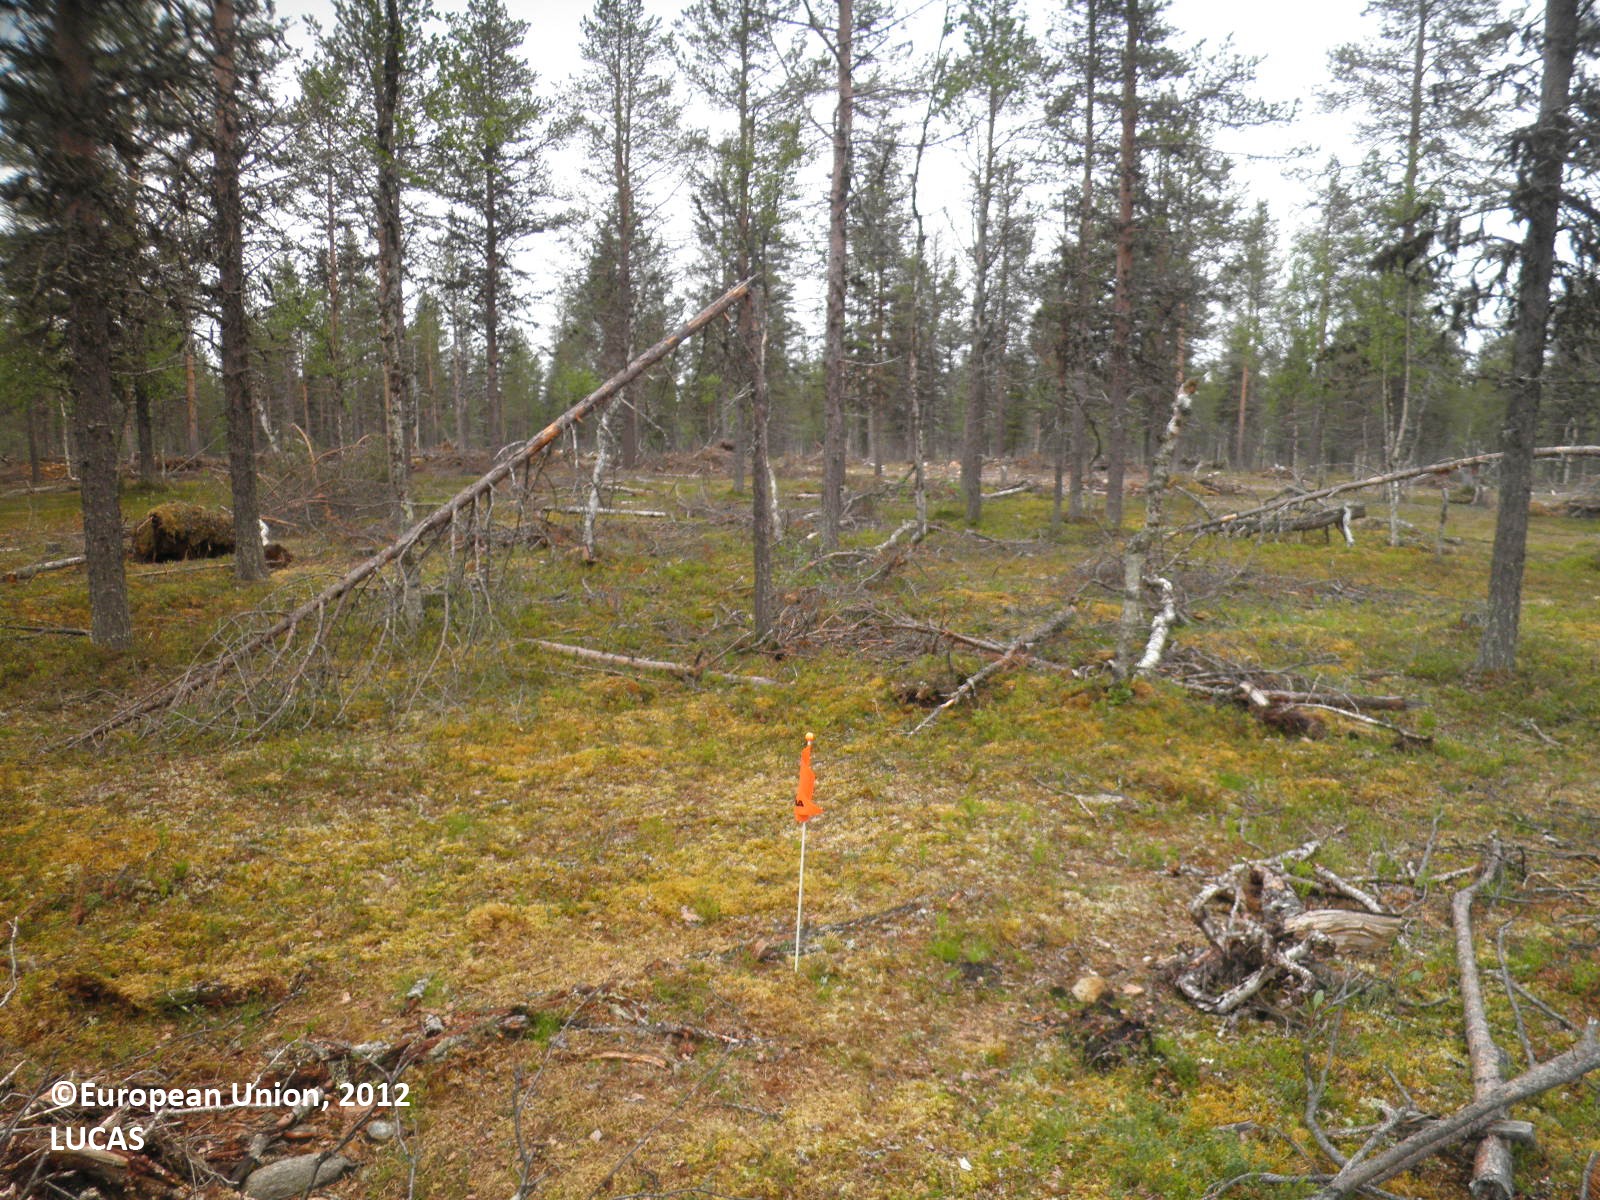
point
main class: Woodland
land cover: Pine dominated coniferous woodland
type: boreal forest
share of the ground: 25 - 50 %
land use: Forestry
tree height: > 5 m
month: July
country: FI
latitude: 68.2420
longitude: 25.5332
